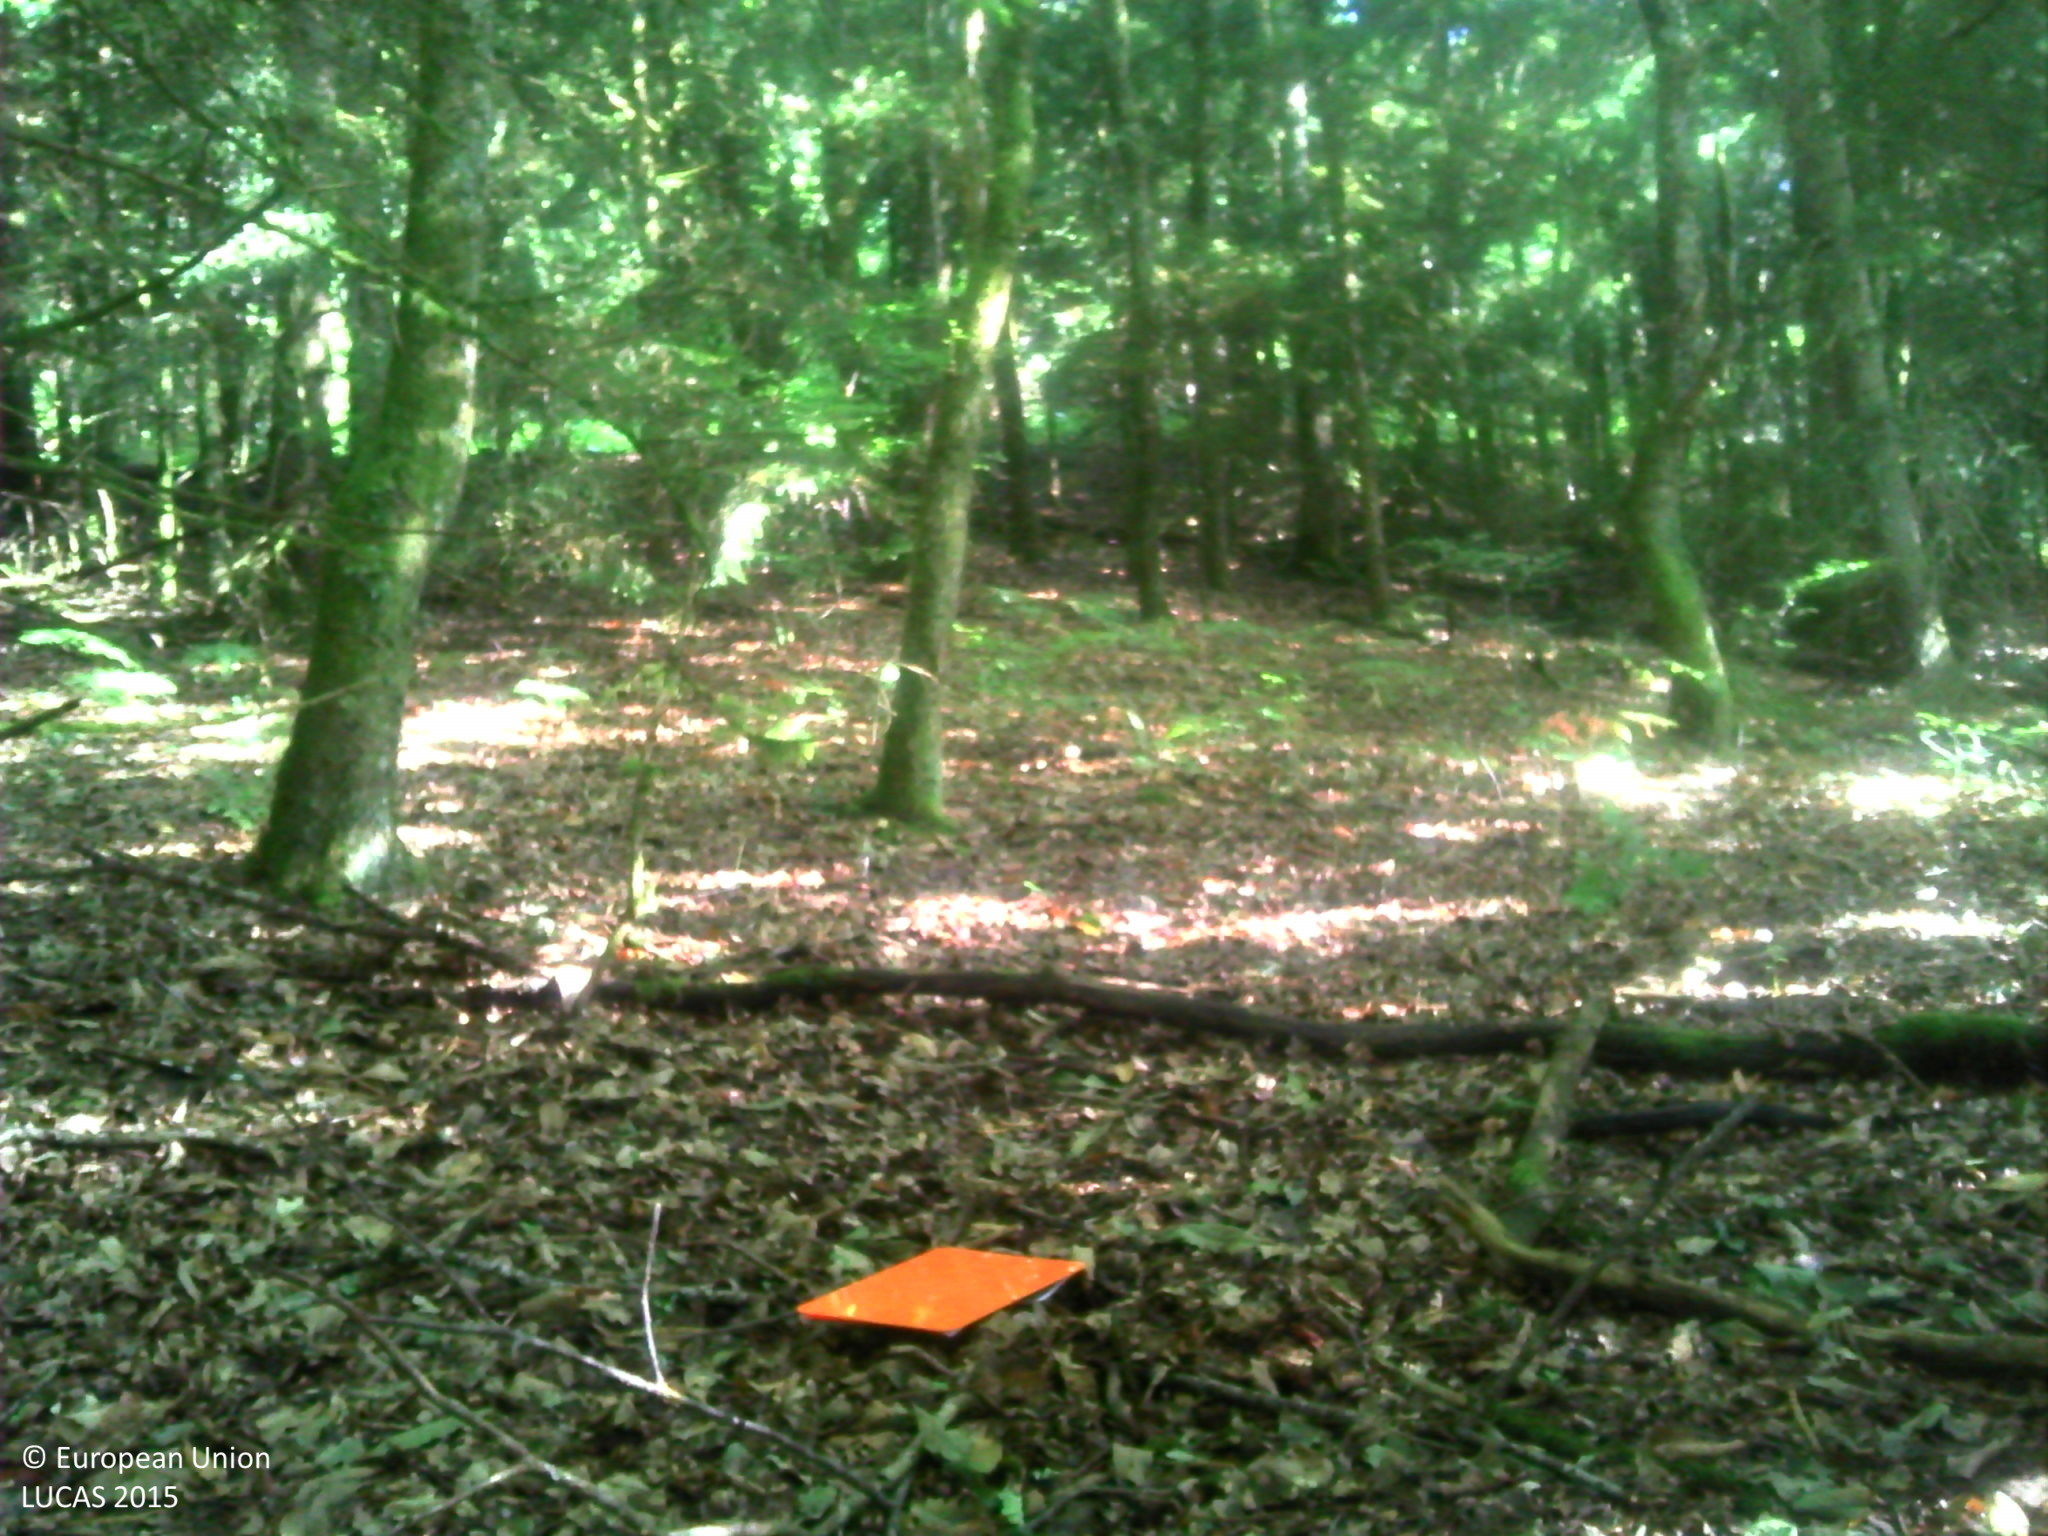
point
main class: Woodland
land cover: Spruce dominated mixed woodland
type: thermophilous deciduous forest
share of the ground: 50 - 75 %
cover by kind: coniferous forest trees 65 %, broadleaved forest trees 25 %, herbaceous plants 5 %, lichens and mosses 5 %
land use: Forestry
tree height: > 5 m
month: July
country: FR
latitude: 45.6156
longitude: 1.7487
